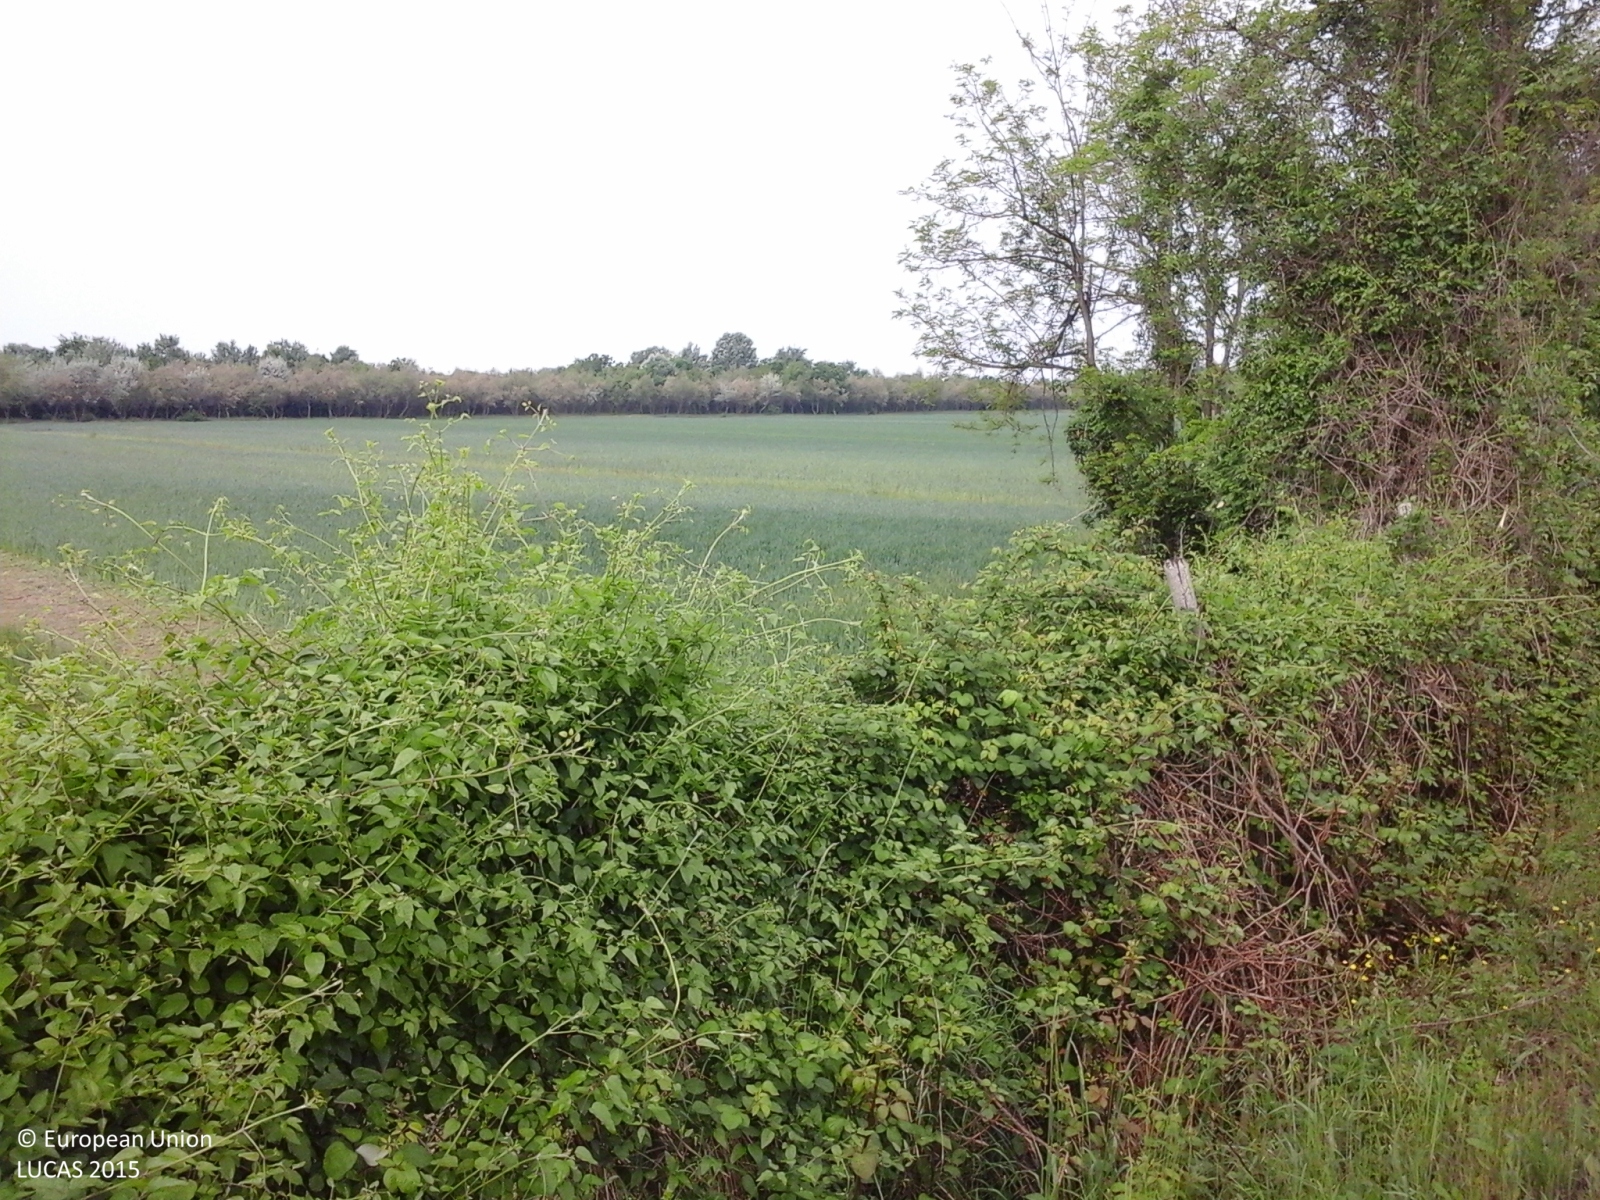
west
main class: Cropland
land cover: Maize
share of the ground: < 10 %
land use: Agriculture (excluding fallow land and kitchen gardens)
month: May
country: IT
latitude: 45.5446
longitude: 12.5961
